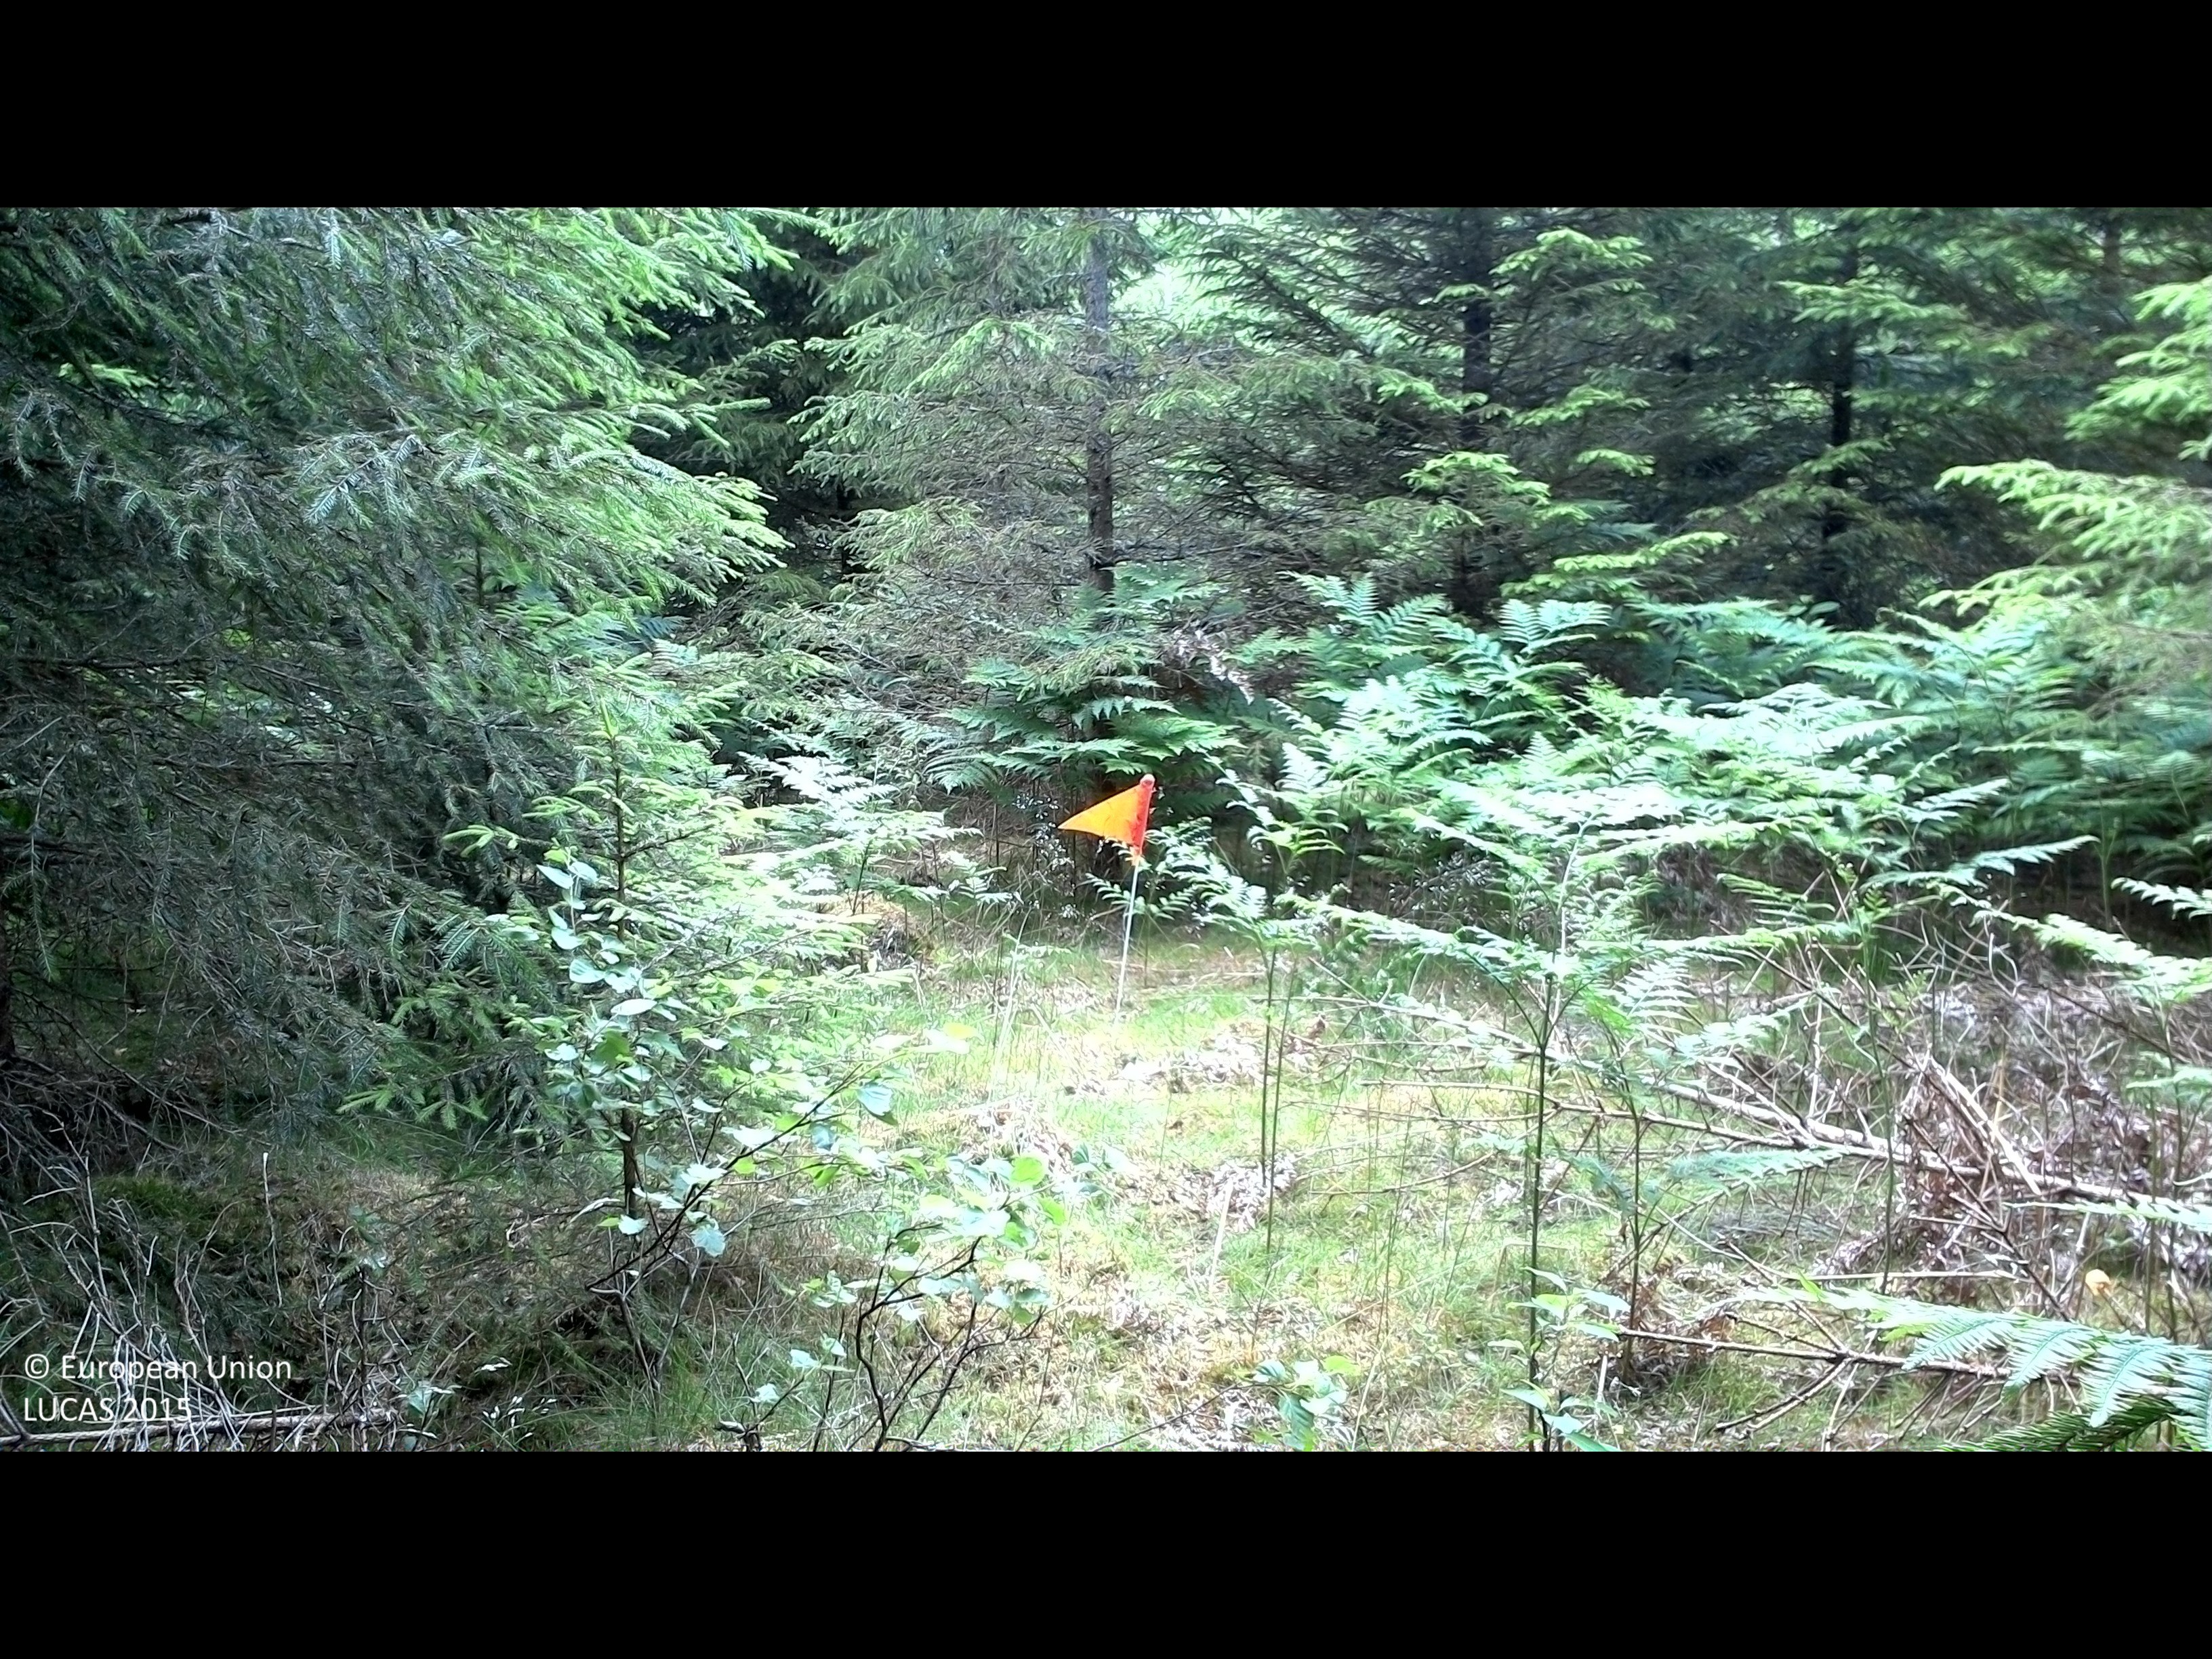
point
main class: Woodland
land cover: Spruce dominated coniferous woodland
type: boreal forest
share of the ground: > 75 %
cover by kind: coniferous forest trees 75 %, shrubs 10 %, herbaceous plants 10 %, broadleaved forest trees 5 %
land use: Forestry
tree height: < 5 m
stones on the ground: < 10 %
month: July
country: SE
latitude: 56.4959
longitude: 14.7571
